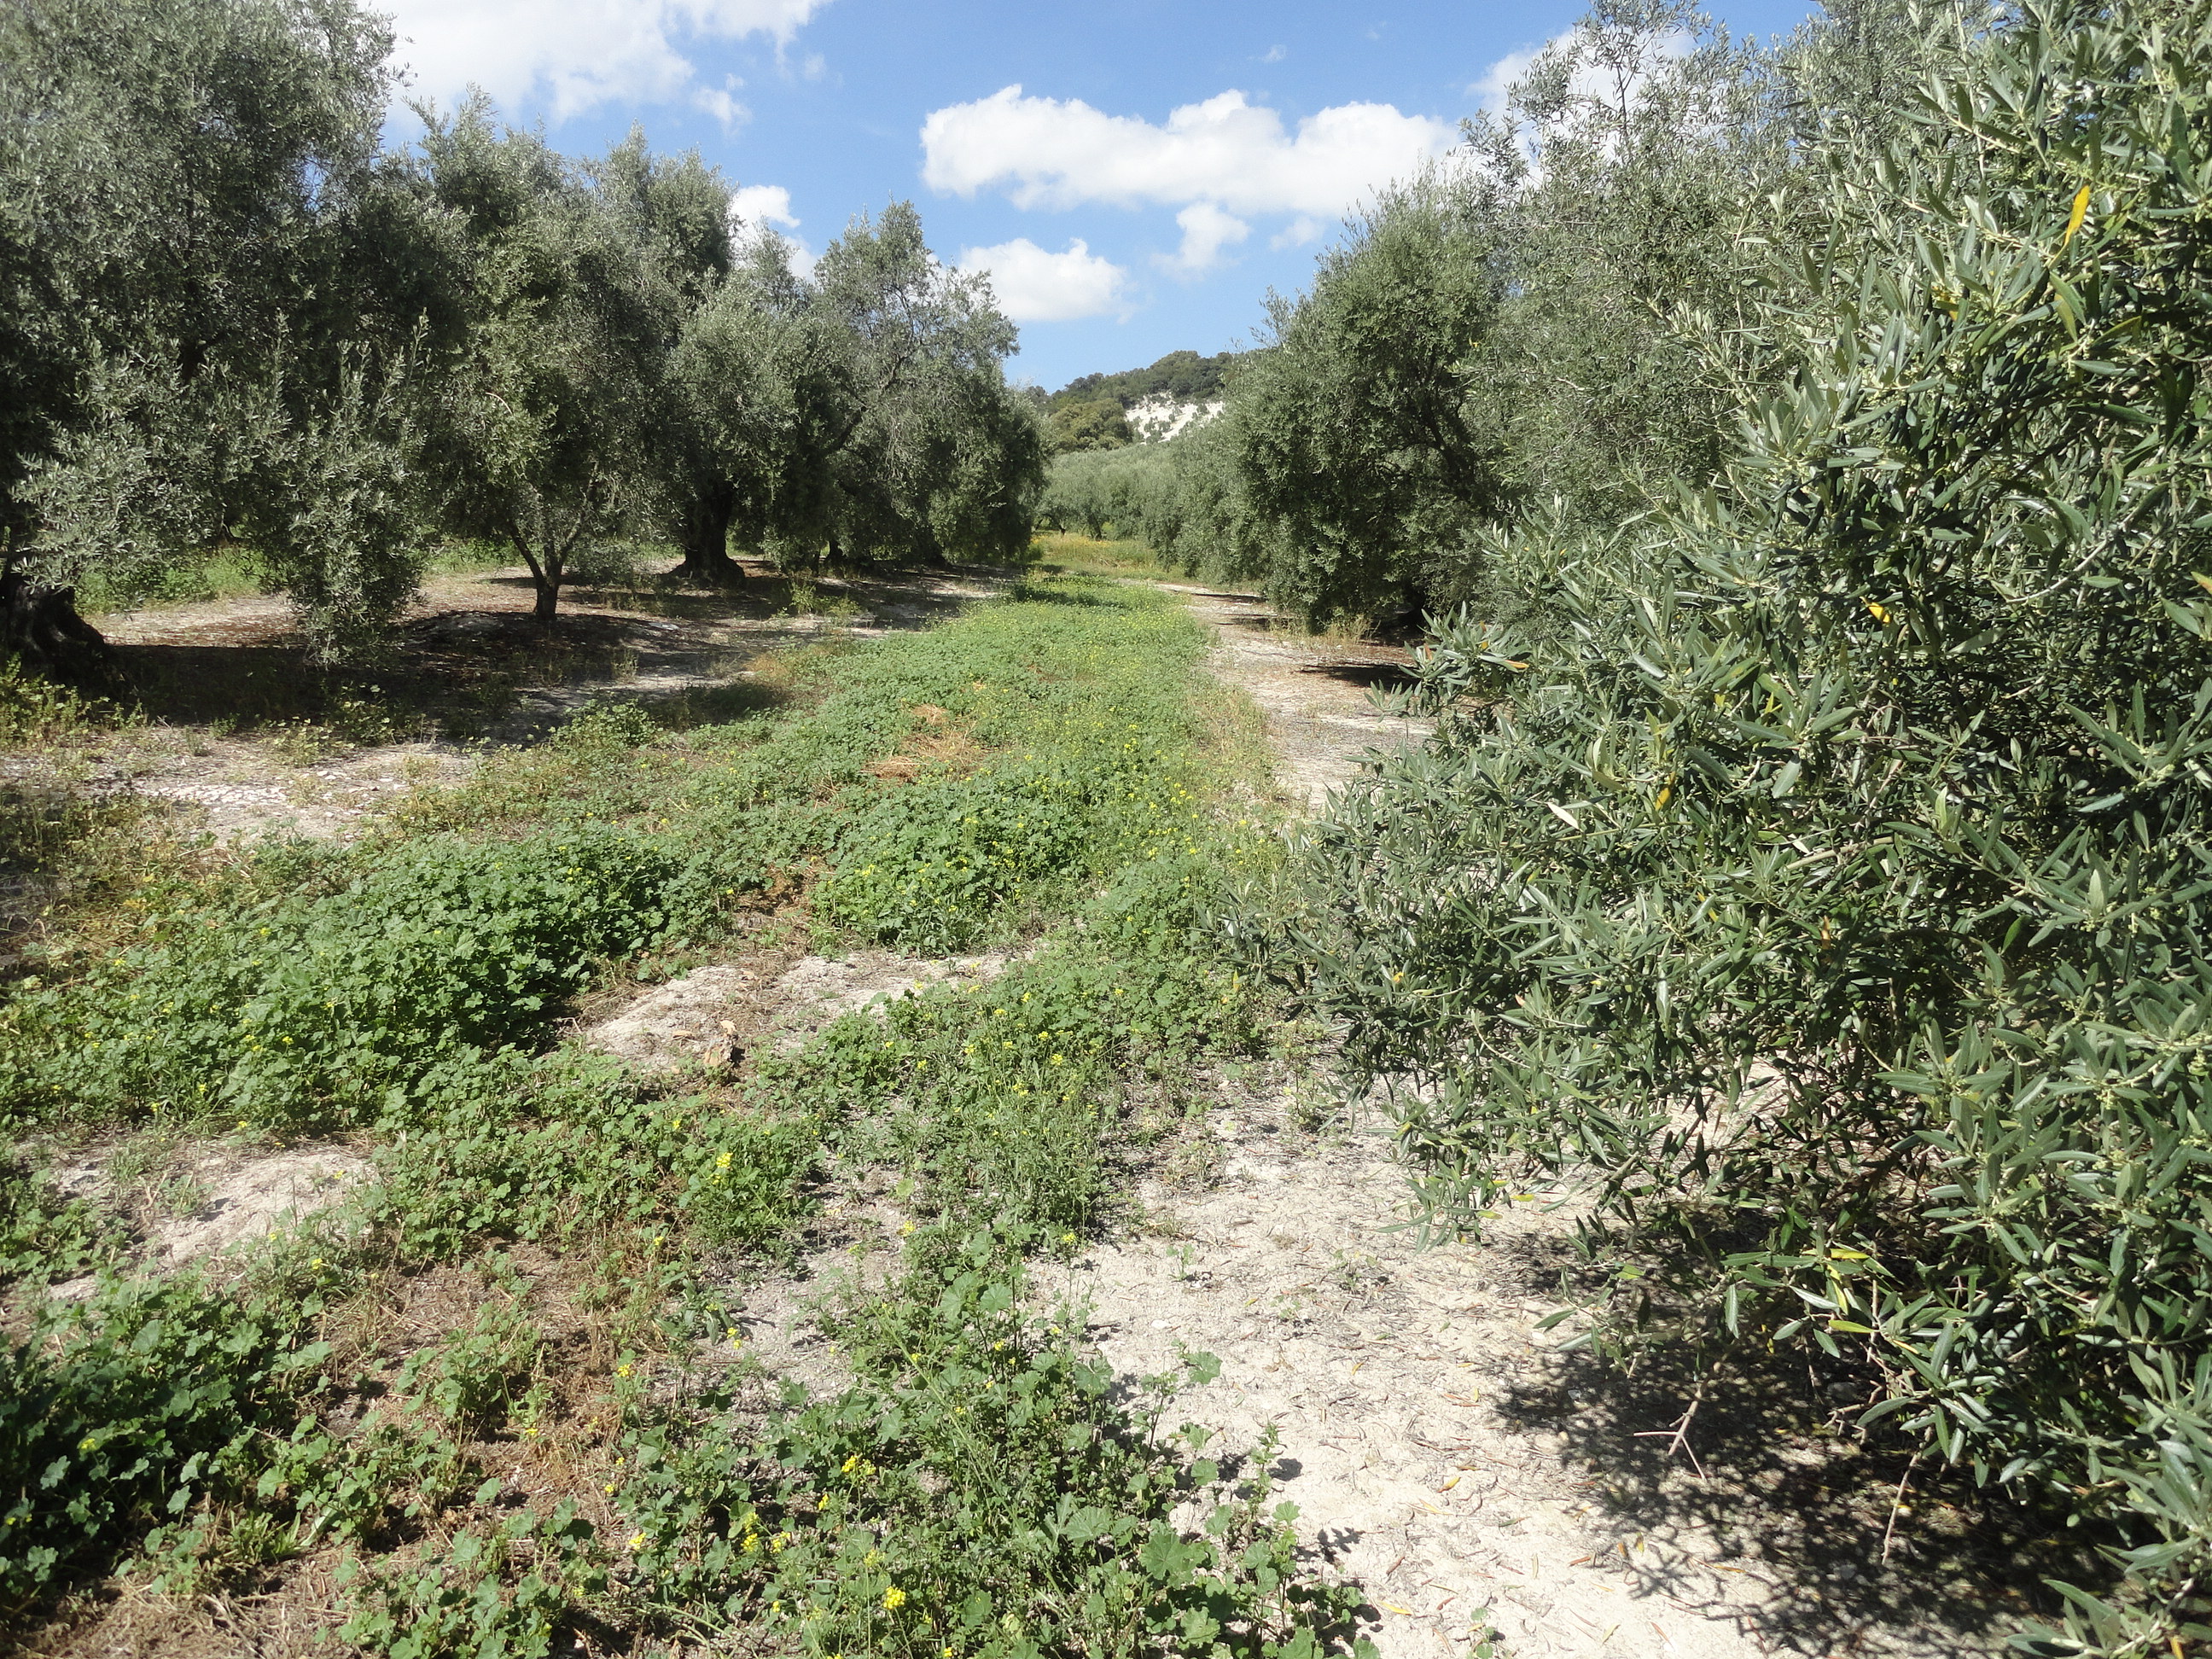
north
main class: Cropland
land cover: Olive groves
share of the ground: 50 - 75 %
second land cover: Spontaneously vegetated surfaces
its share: 10 - 25 %
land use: Agriculture (excluding fallow land and kitchen gardens)
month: April
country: ES
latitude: 37.5485
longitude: -4.5046
